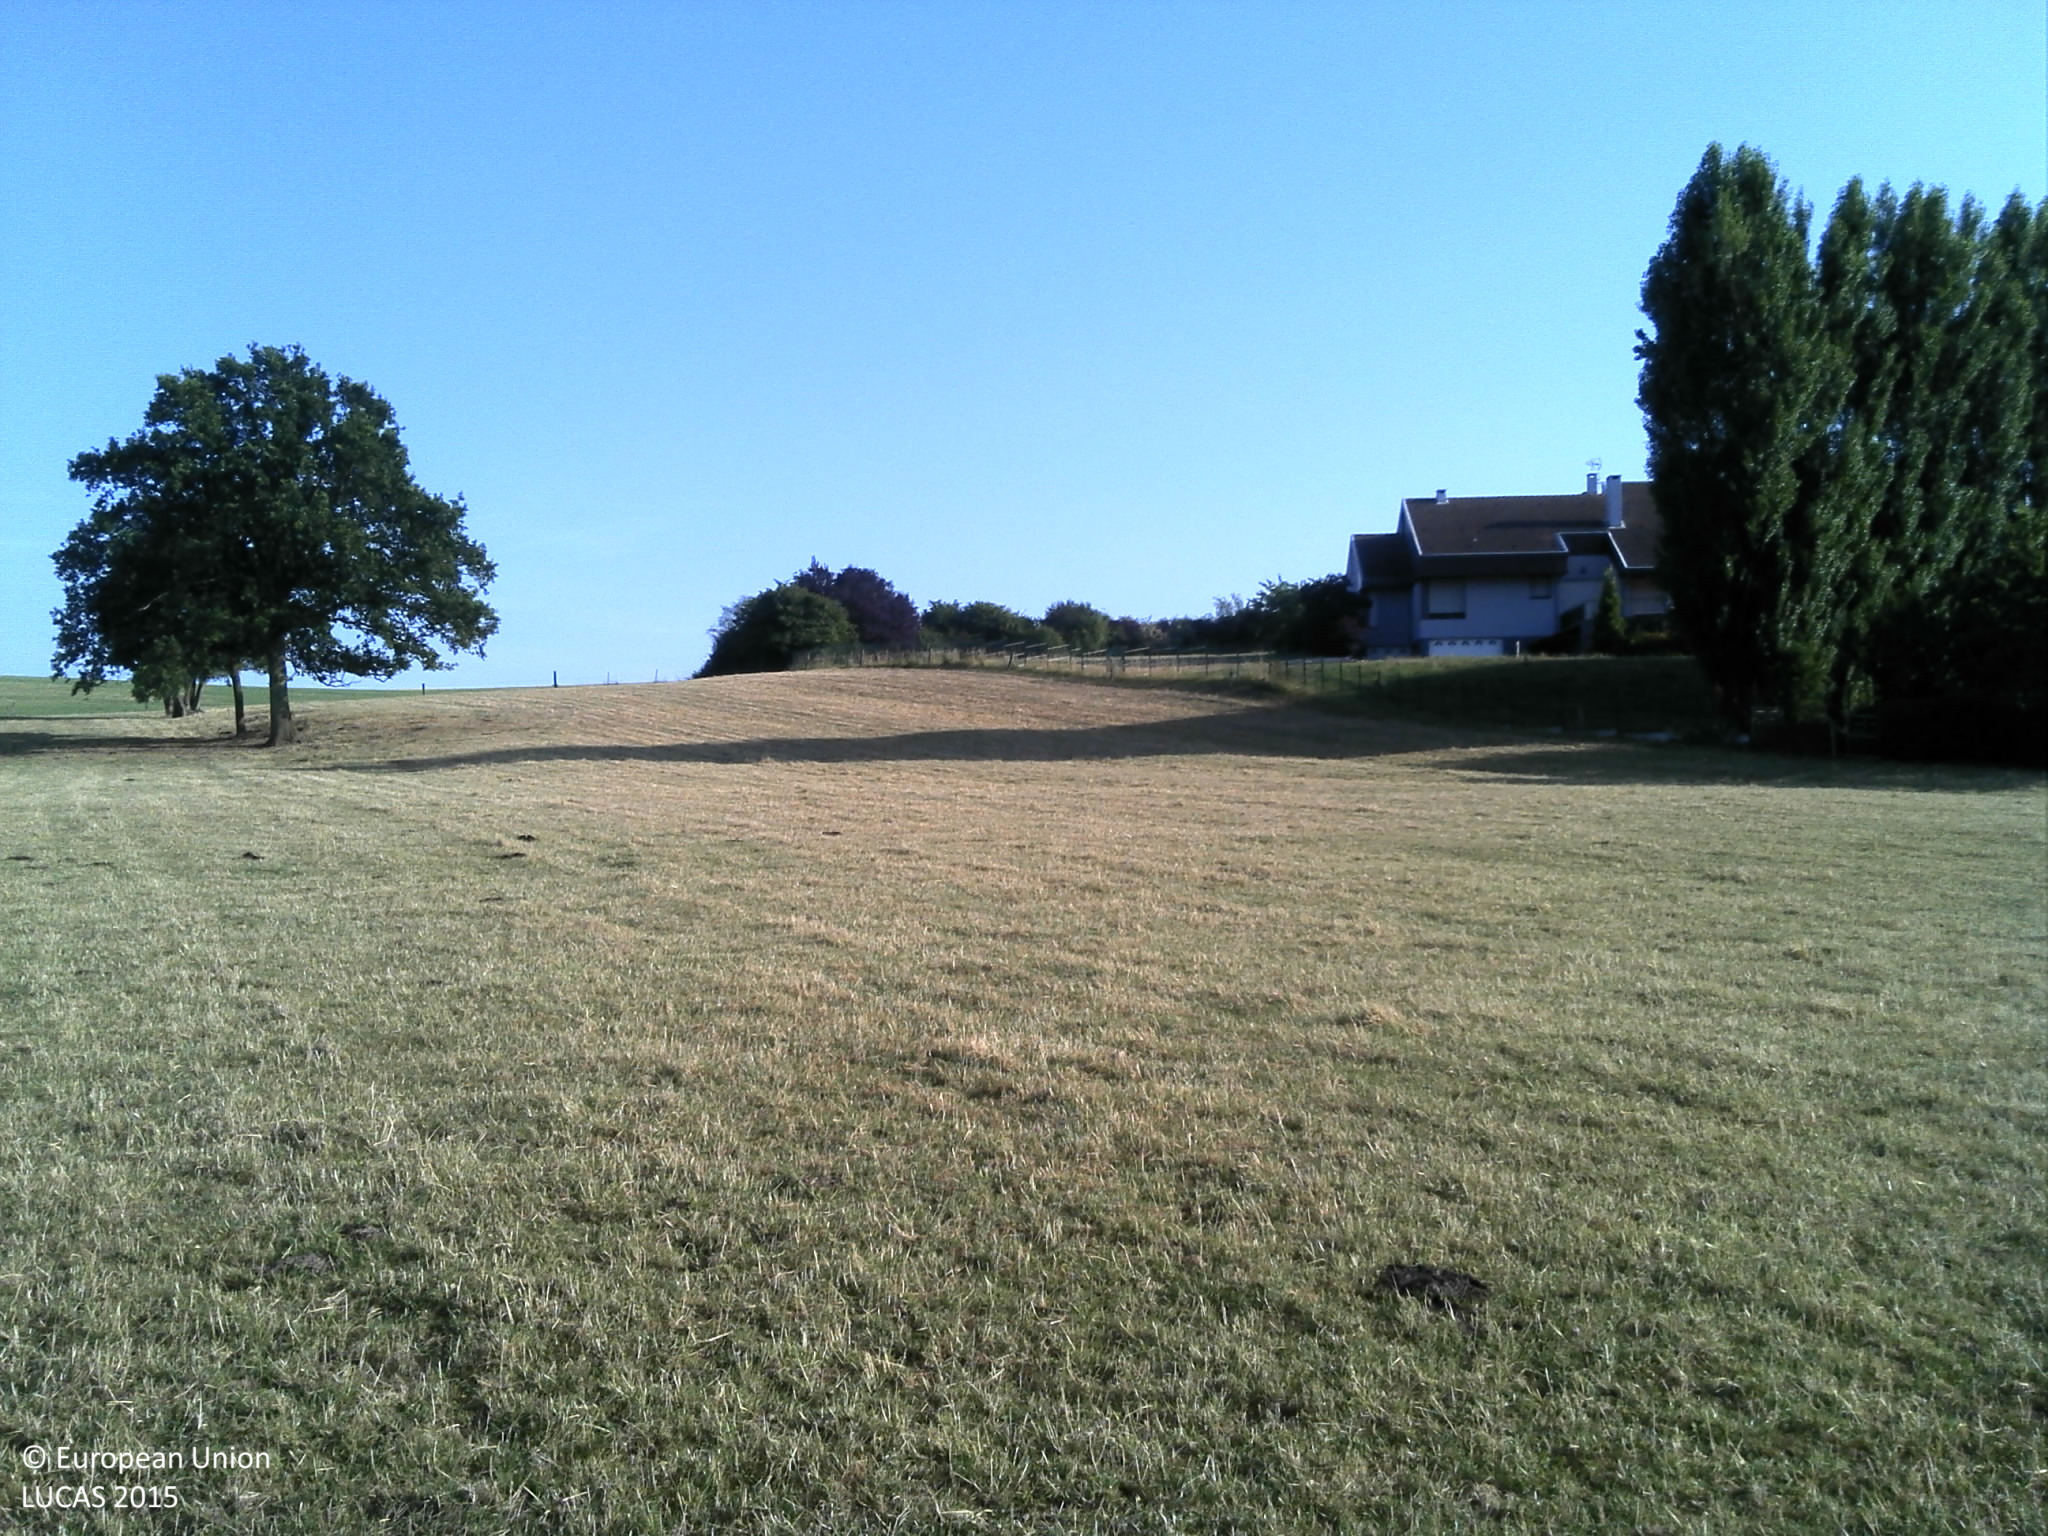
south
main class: Grassland
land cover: Grassland without tree/shrub cover
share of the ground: > 75 %
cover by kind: herbaceous plants 100 %
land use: Agriculture (excluding fallow land and kitchen gardens)
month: July
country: FR
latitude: 49.0941
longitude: 6.7546
